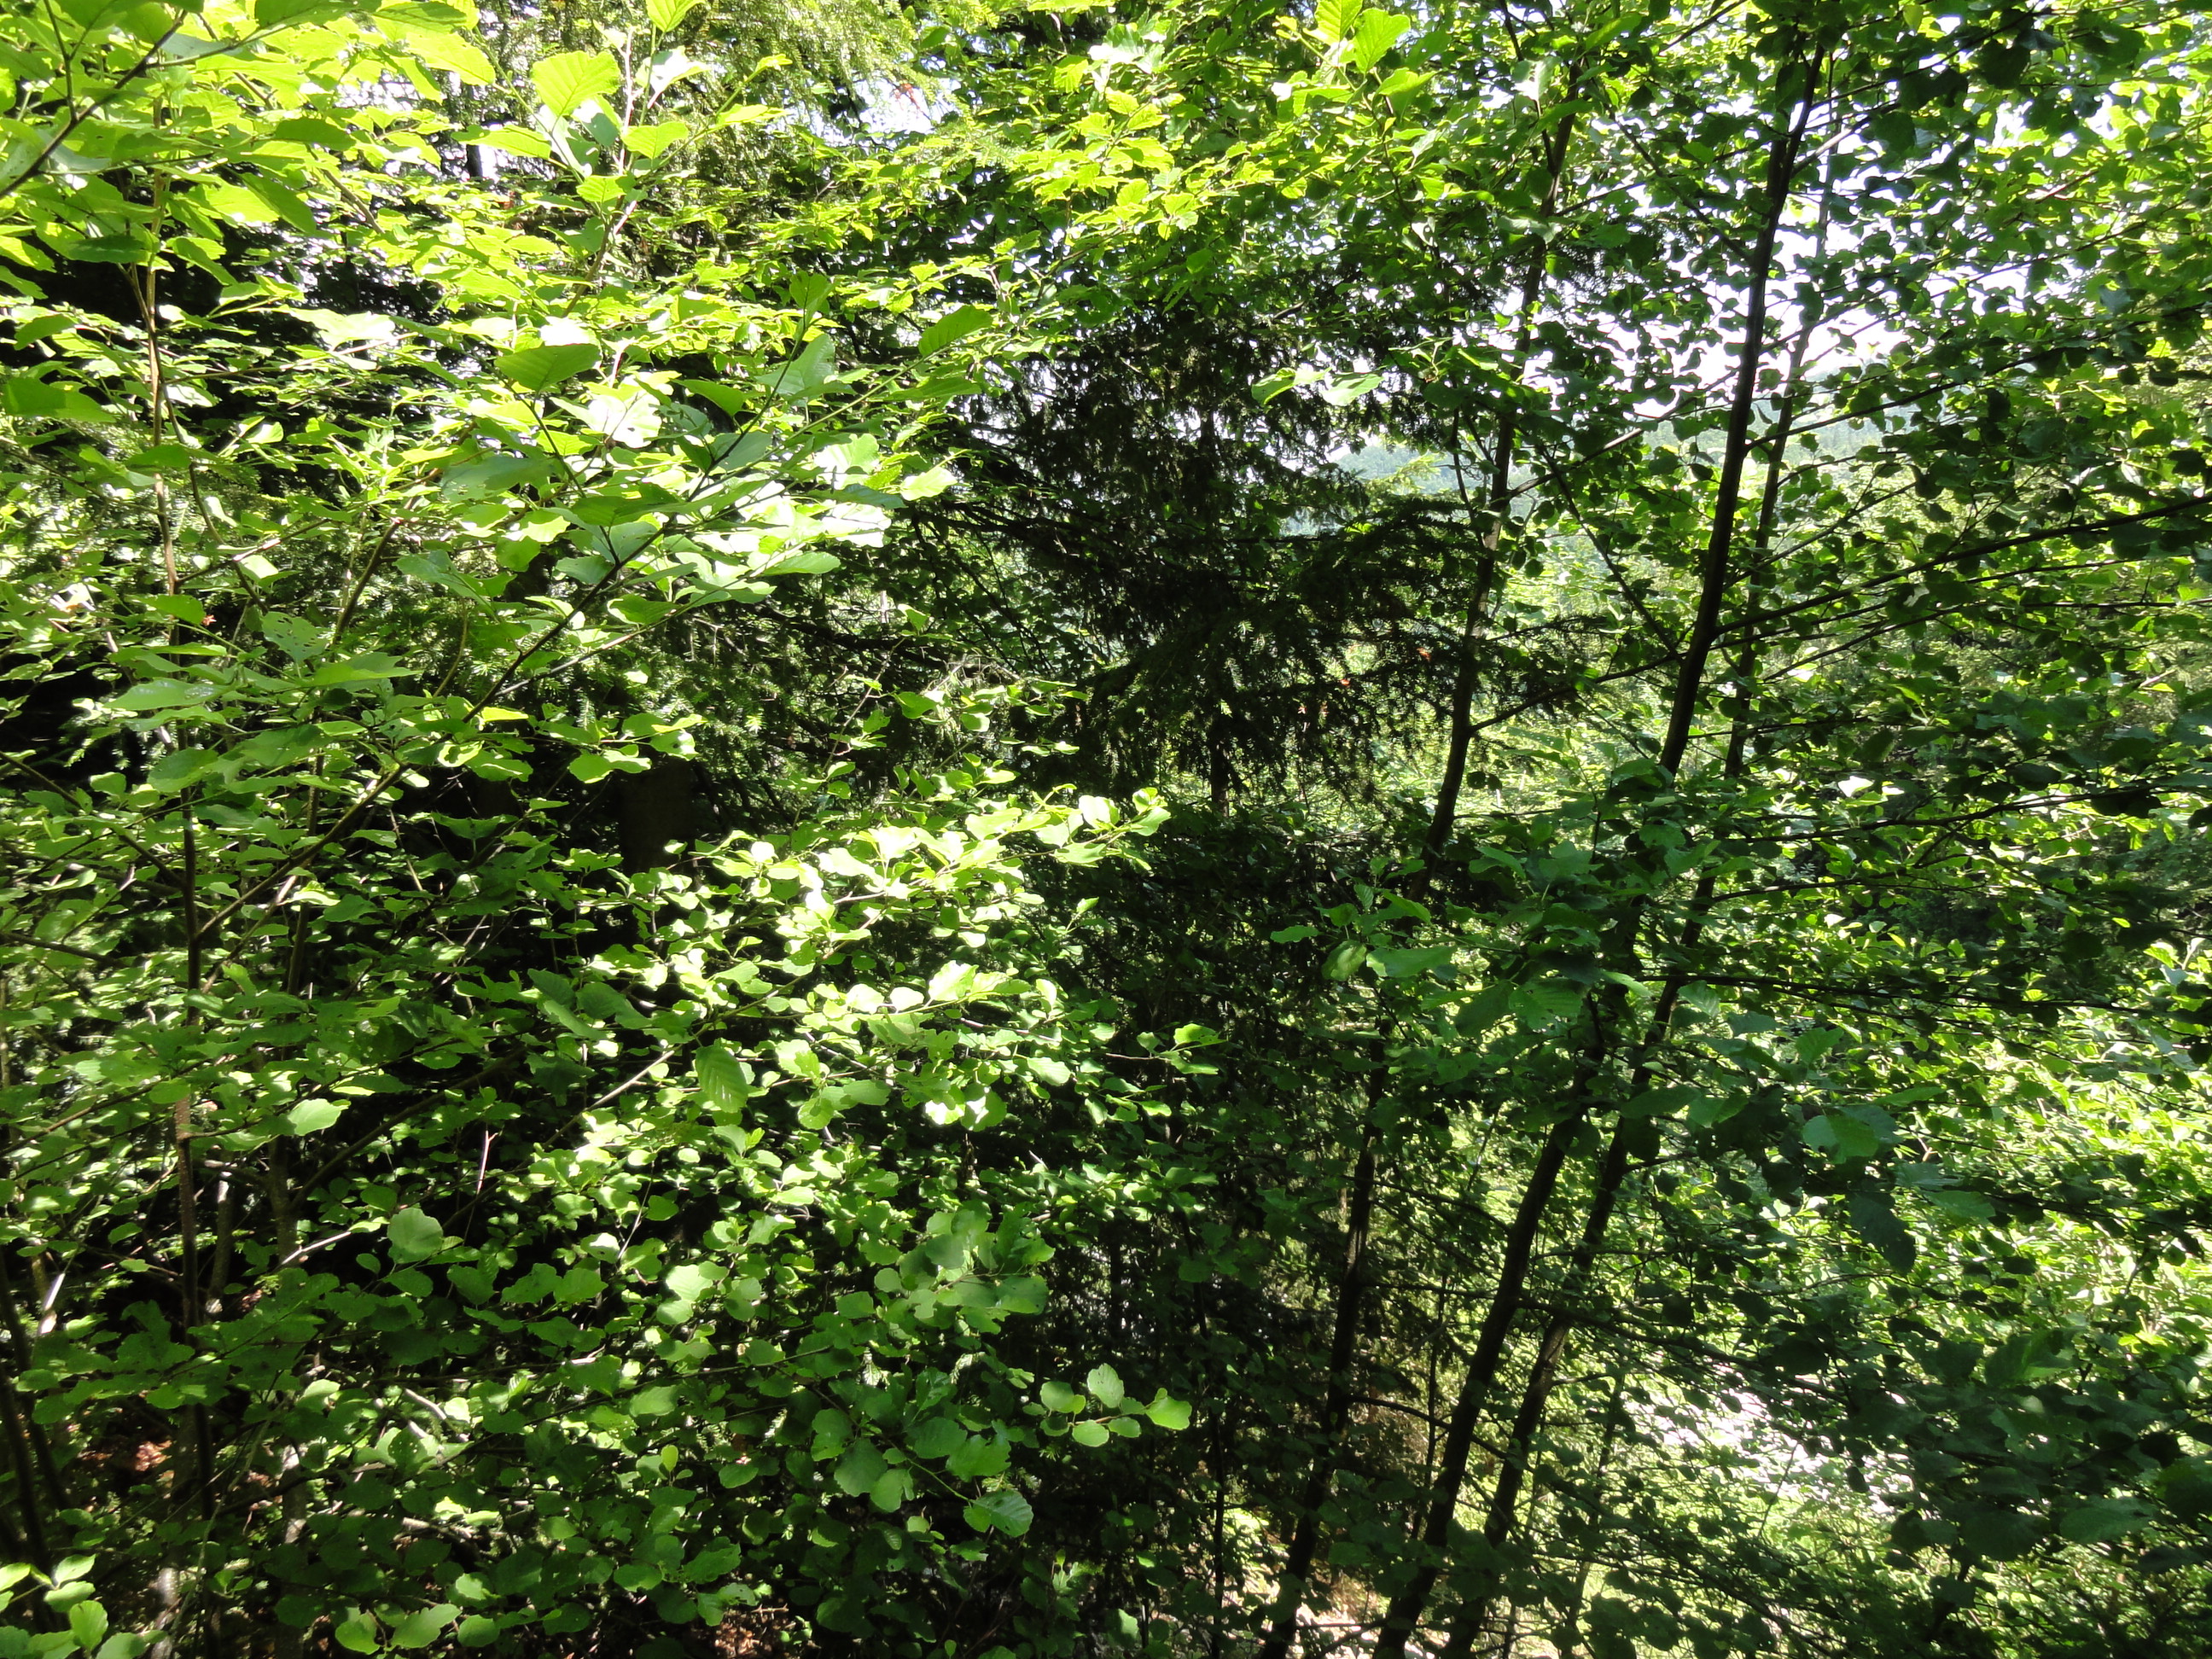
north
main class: Woodland
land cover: Spruce dominated mixed woodland
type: hemiboreal forest and nemoral coniferous forest and mixed broadleaved-coniferous forest
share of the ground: > 75 %
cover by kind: broadleaved forest trees 50 %, coniferous forest trees 40 %, shrubs 5 %, unconsolidated bare surface 5 %
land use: Forestry
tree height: > 5 m
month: June
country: SI
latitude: 46.1964
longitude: 15.0381
